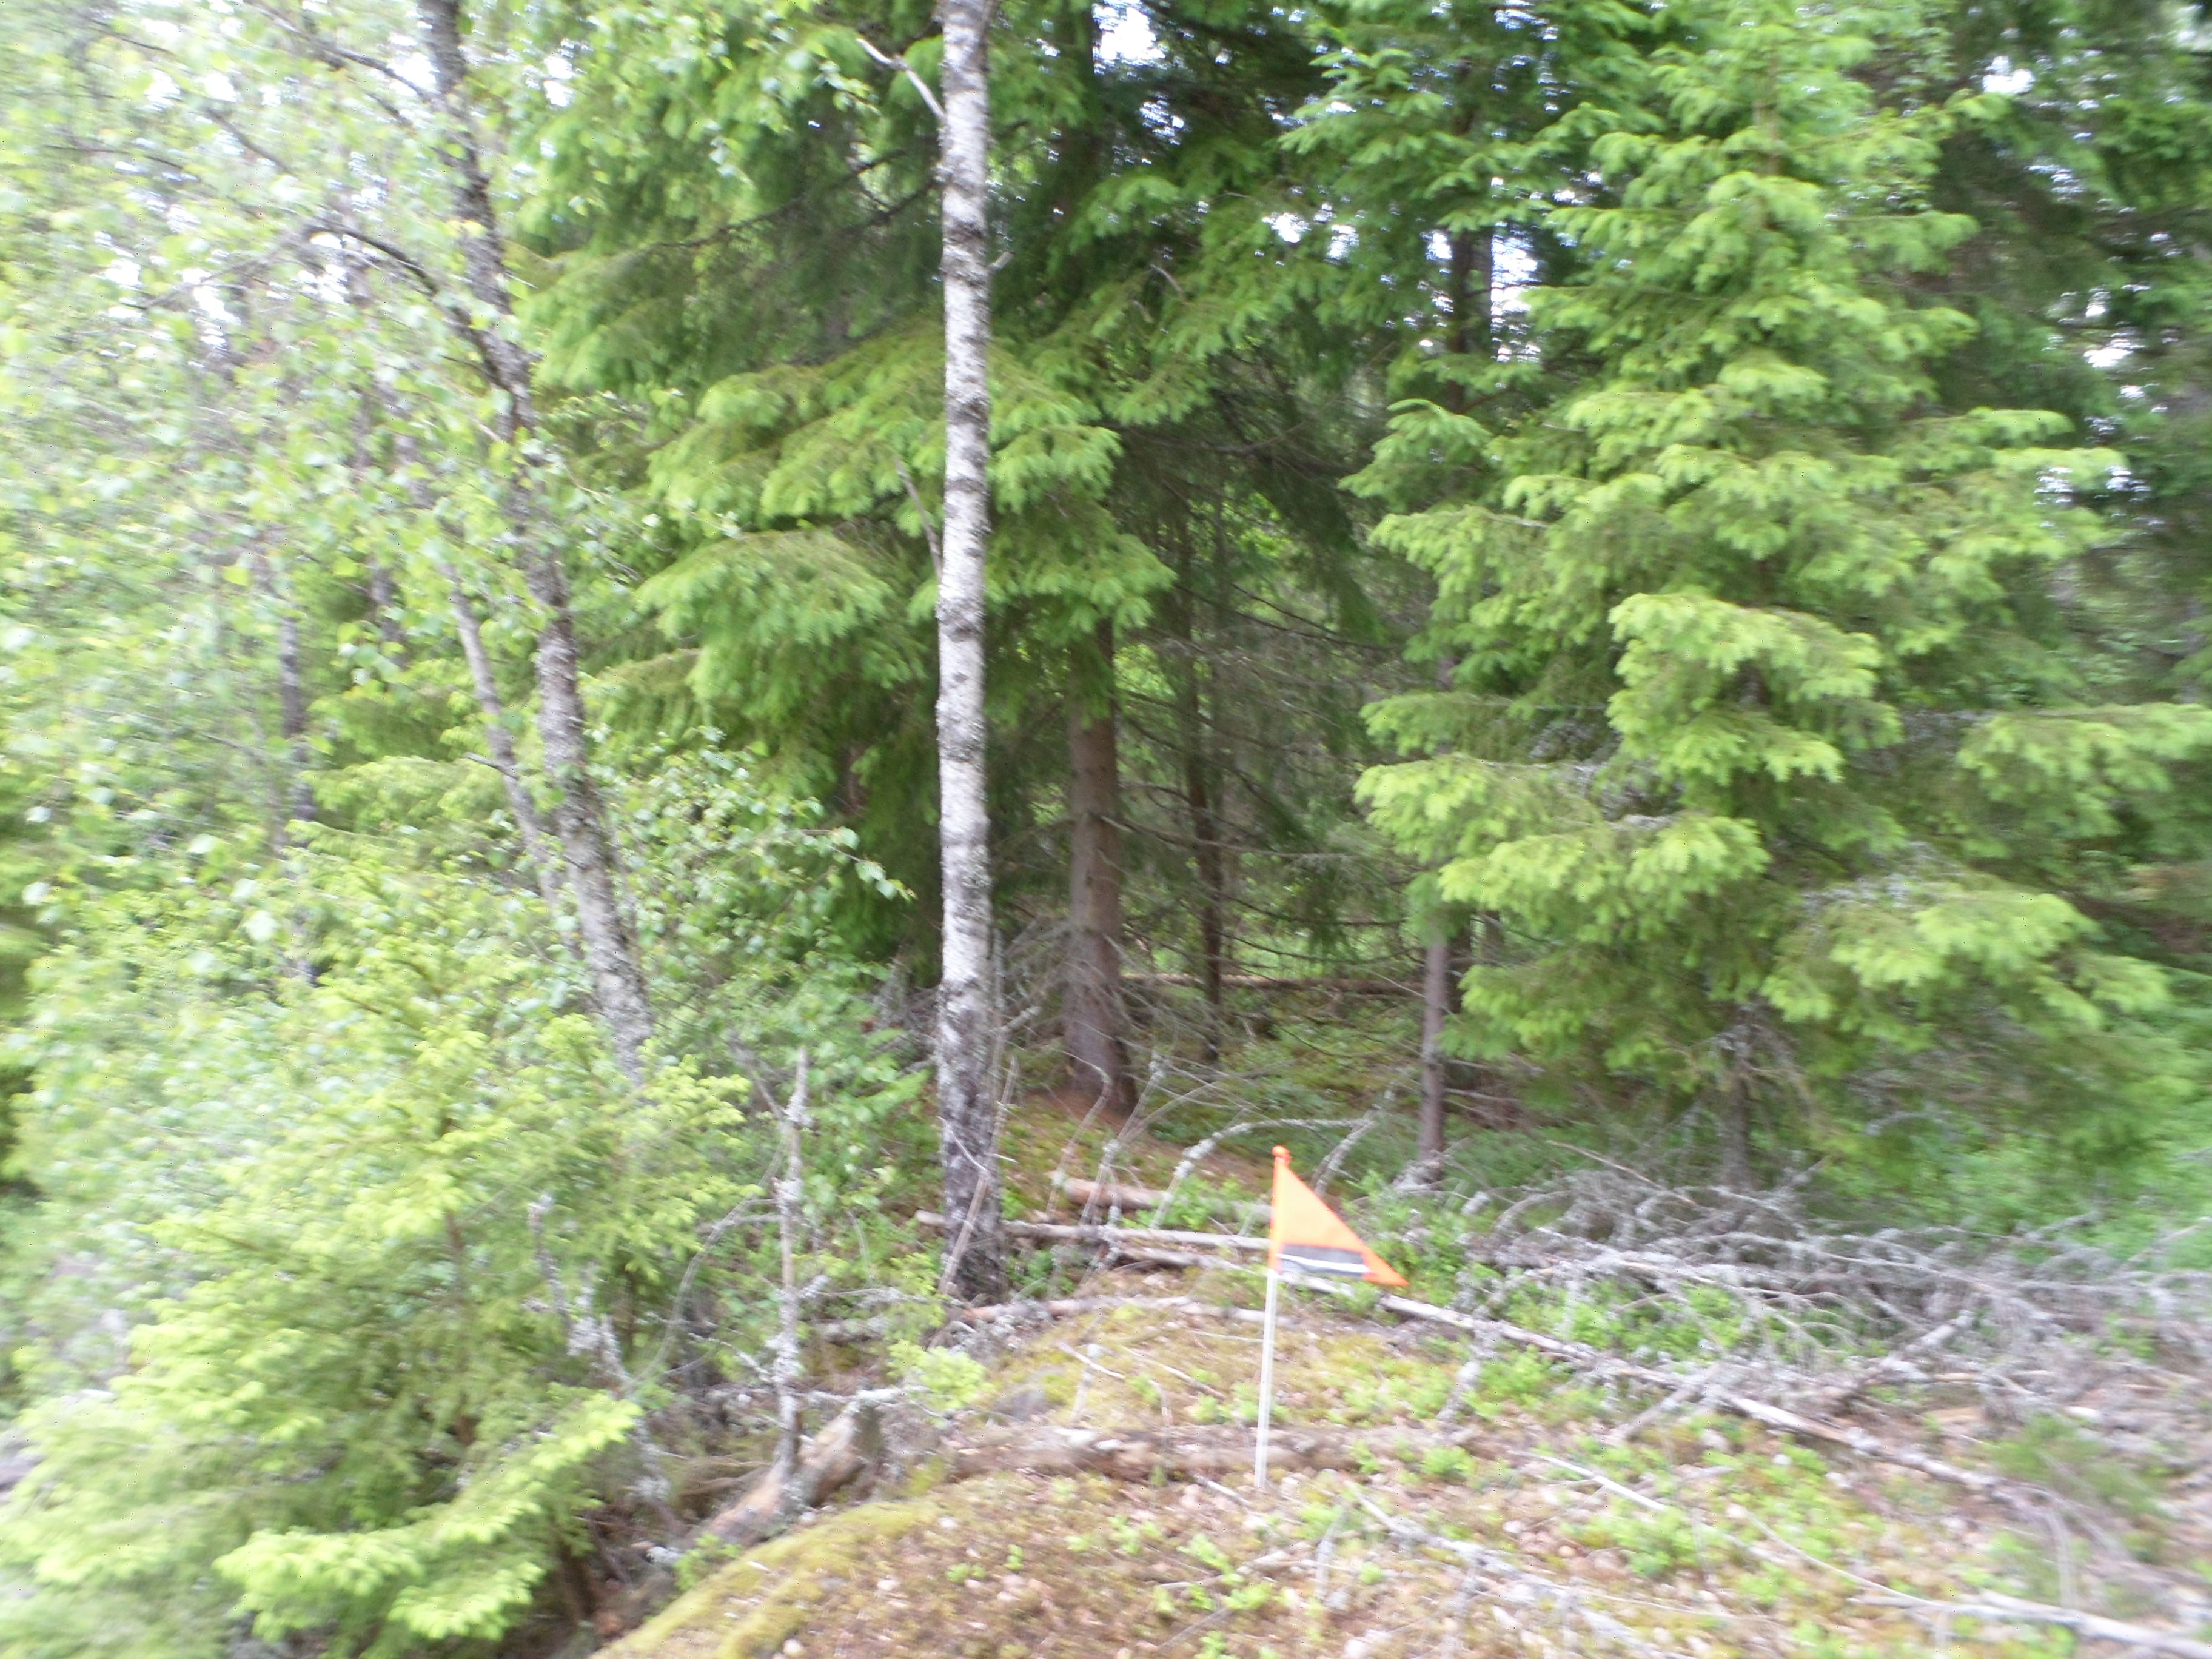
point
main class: Woodland
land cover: Spruce dominated mixed woodland
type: boreal forest
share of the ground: 25 - 50 %
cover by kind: lichens and mosses 25 %, broadleaved forest trees 20 %, unconsolidated bare surface 20 %, coniferous forest trees 15 %, shrubs 15 %, herbaceous plants 5 %
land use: Forestry
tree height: > 5 m
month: June
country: SE
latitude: 56.9906
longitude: 14.5227
